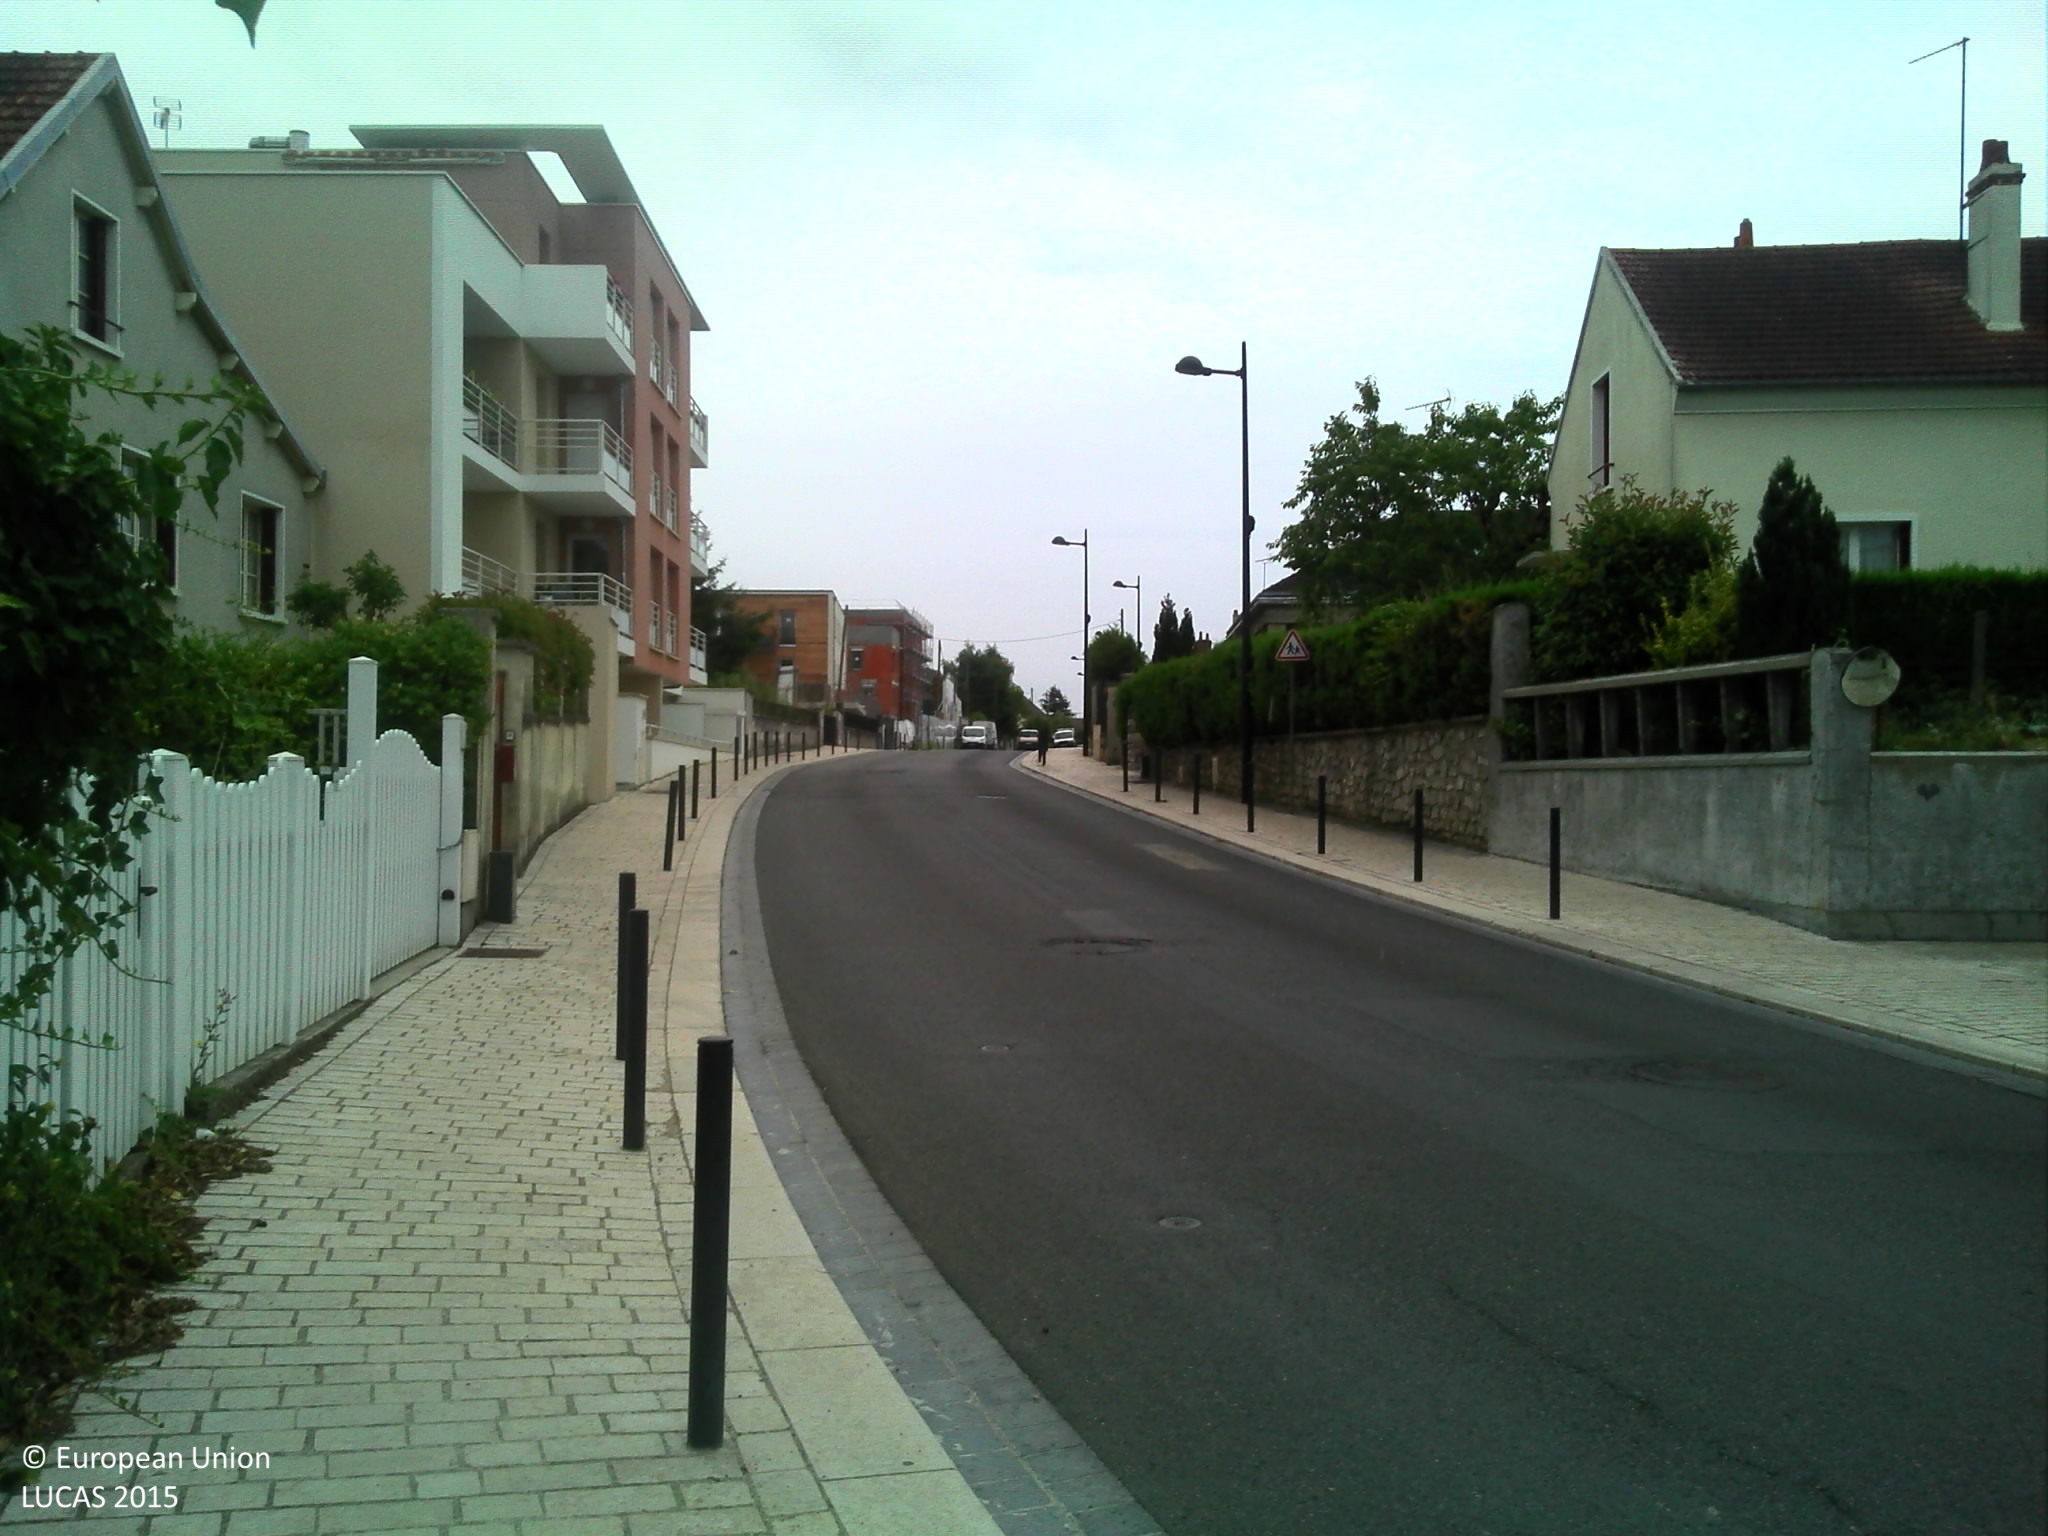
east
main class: Woodland
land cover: Broadleaved woodland
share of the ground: > 75 %
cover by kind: broadleaved forest trees 100 %
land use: Residential
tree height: > 5 m
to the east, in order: Broadleaved woodland; Artificial constructions in urban areas; Spontaneously vegetated surfaces; Artificial constructions in urban areas
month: July
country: FR
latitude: 47.9125
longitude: 1.9732
